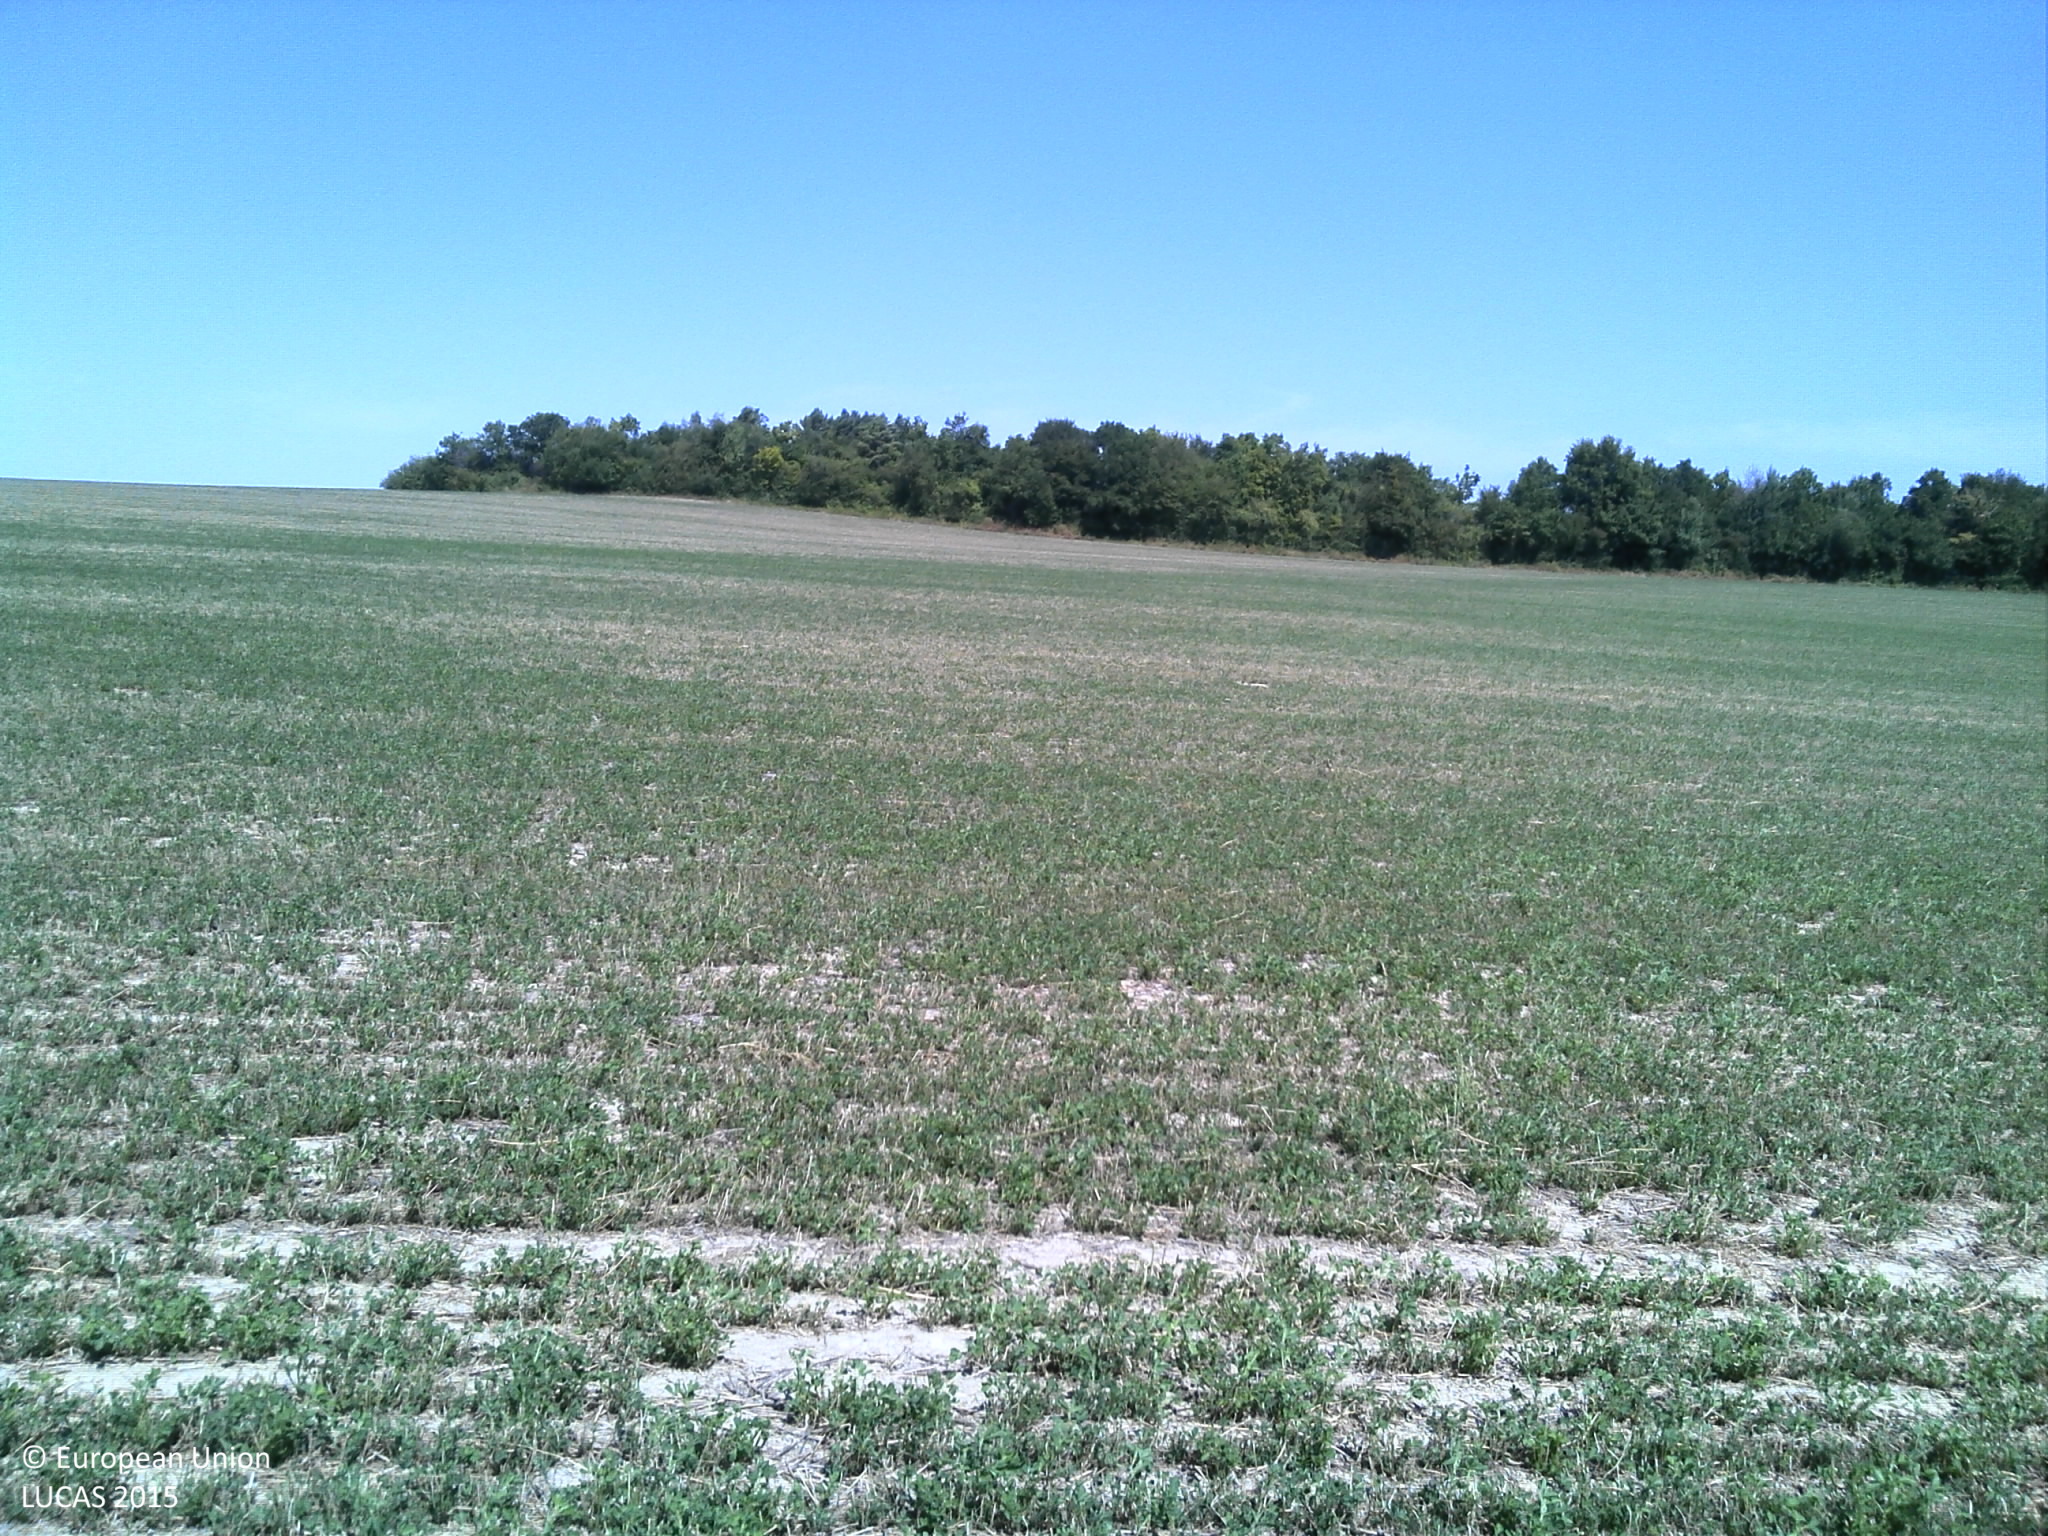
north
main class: Cropland
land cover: Lucerne
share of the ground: > 75 %
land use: Agriculture (excluding fallow land and kitchen gardens)
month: August
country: FR
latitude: 49.2004
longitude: 4.7958
